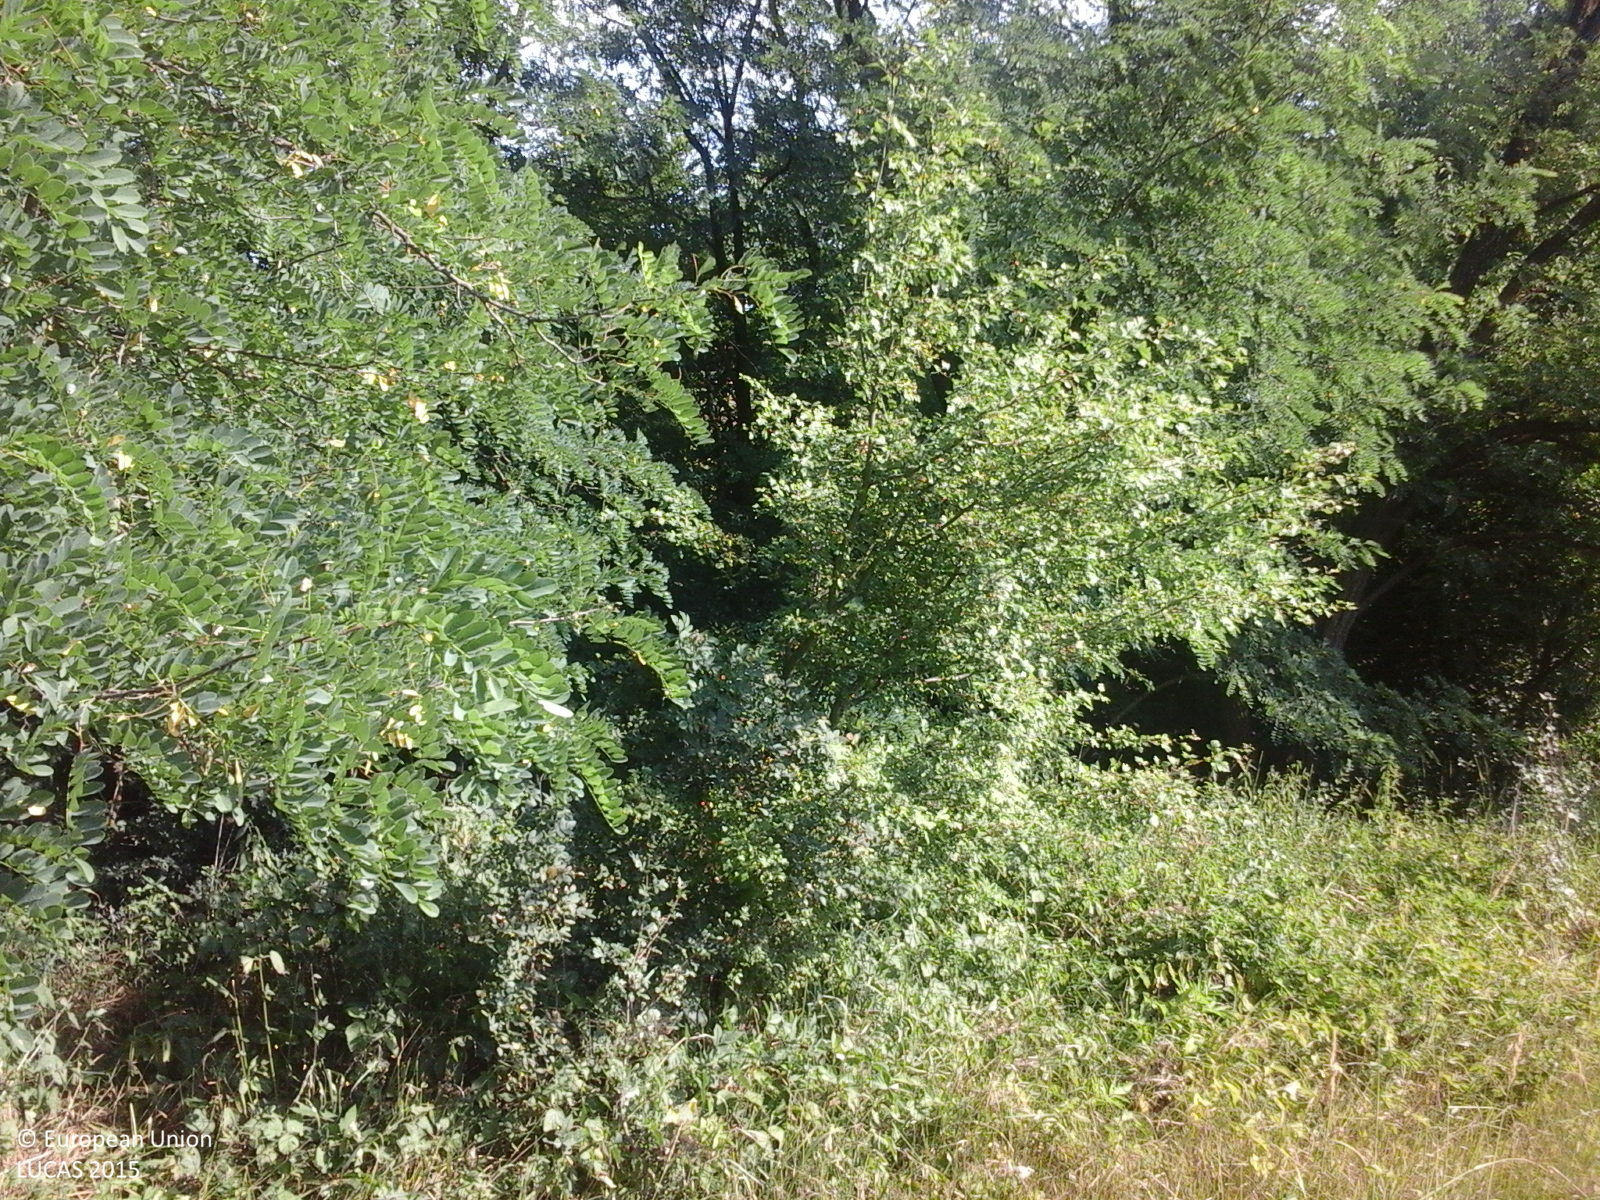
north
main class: Grassland
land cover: Grassland without tree/shrub cover
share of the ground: > 75 %
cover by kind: herbaceous plants 100 %
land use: Agriculture (excluding fallow land and kitchen gardens)
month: July
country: RO
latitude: 46.5495
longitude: 27.1734
